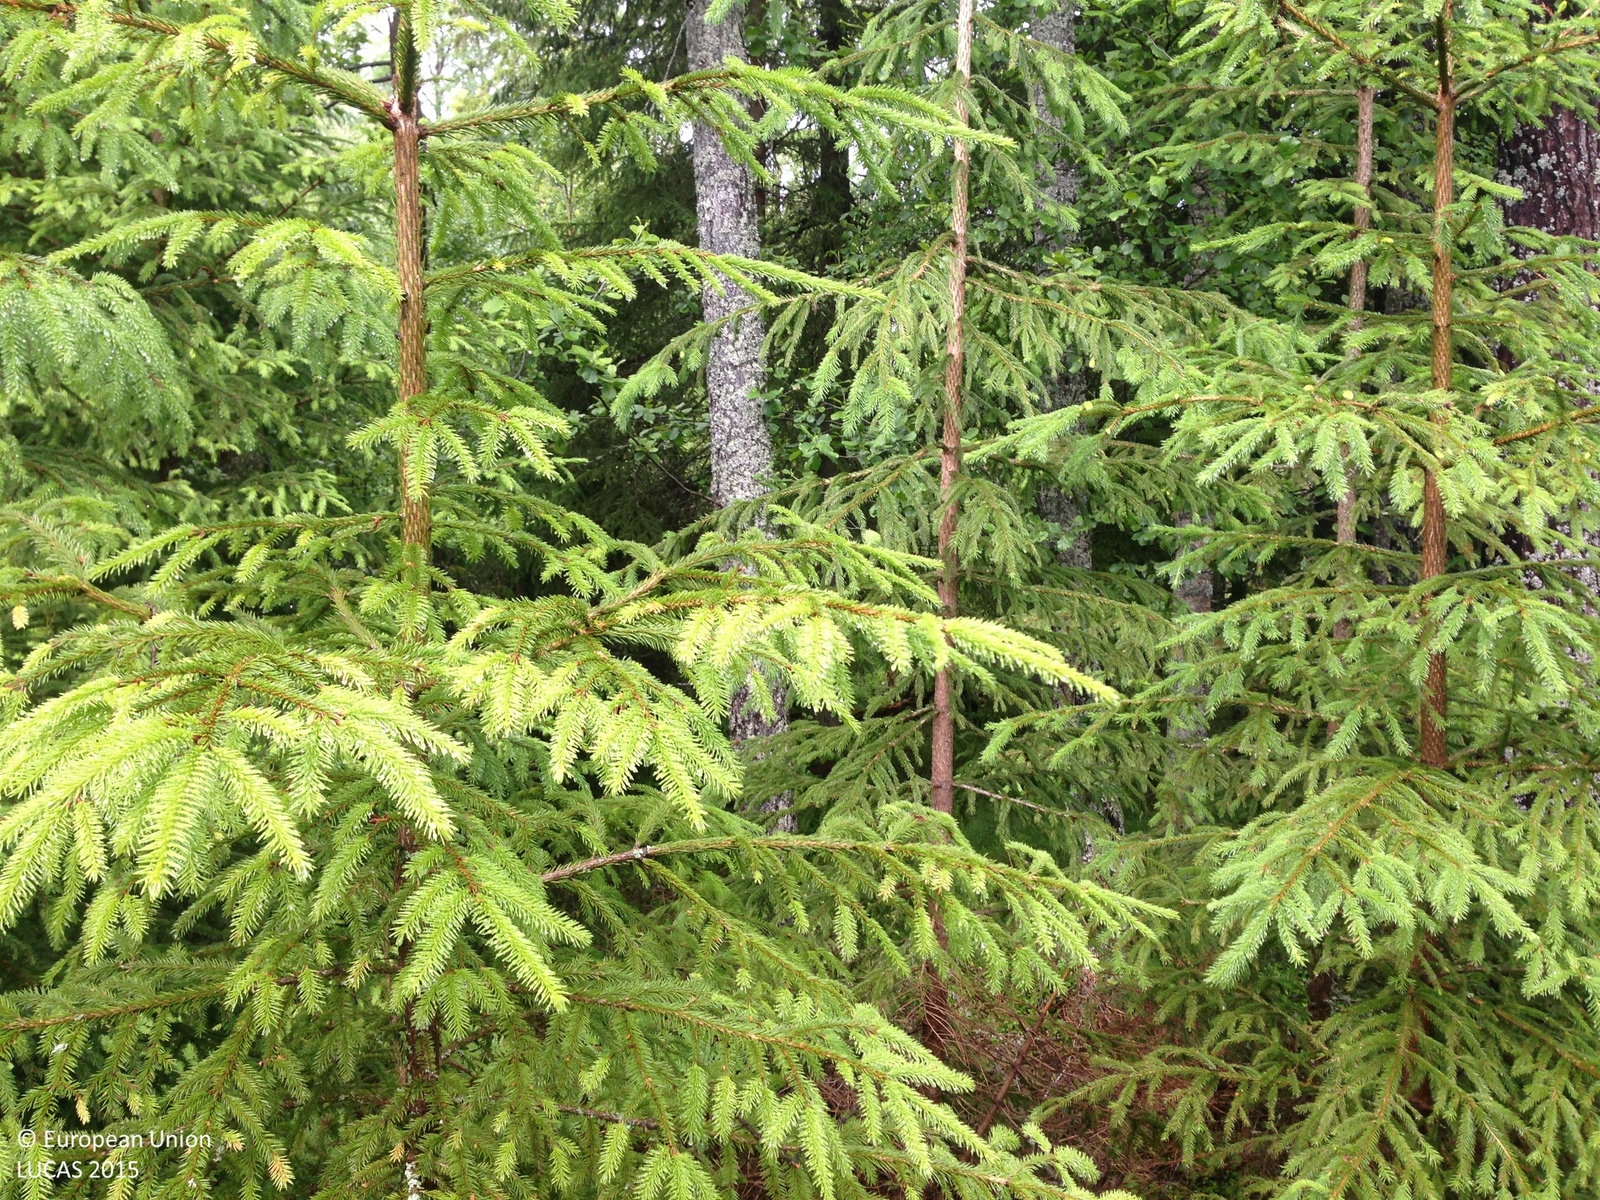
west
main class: Woodland
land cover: Spruce dominated mixed woodland
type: boreal forest
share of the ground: 50 - 75 %
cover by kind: coniferous forest trees 45 %, herbaceous plants 30 %, broadleaved forest trees 20 %, lichens and mosses 5 %
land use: Forestry
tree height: > 5 m
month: June
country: SE
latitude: 58.0951
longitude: 16.1885
